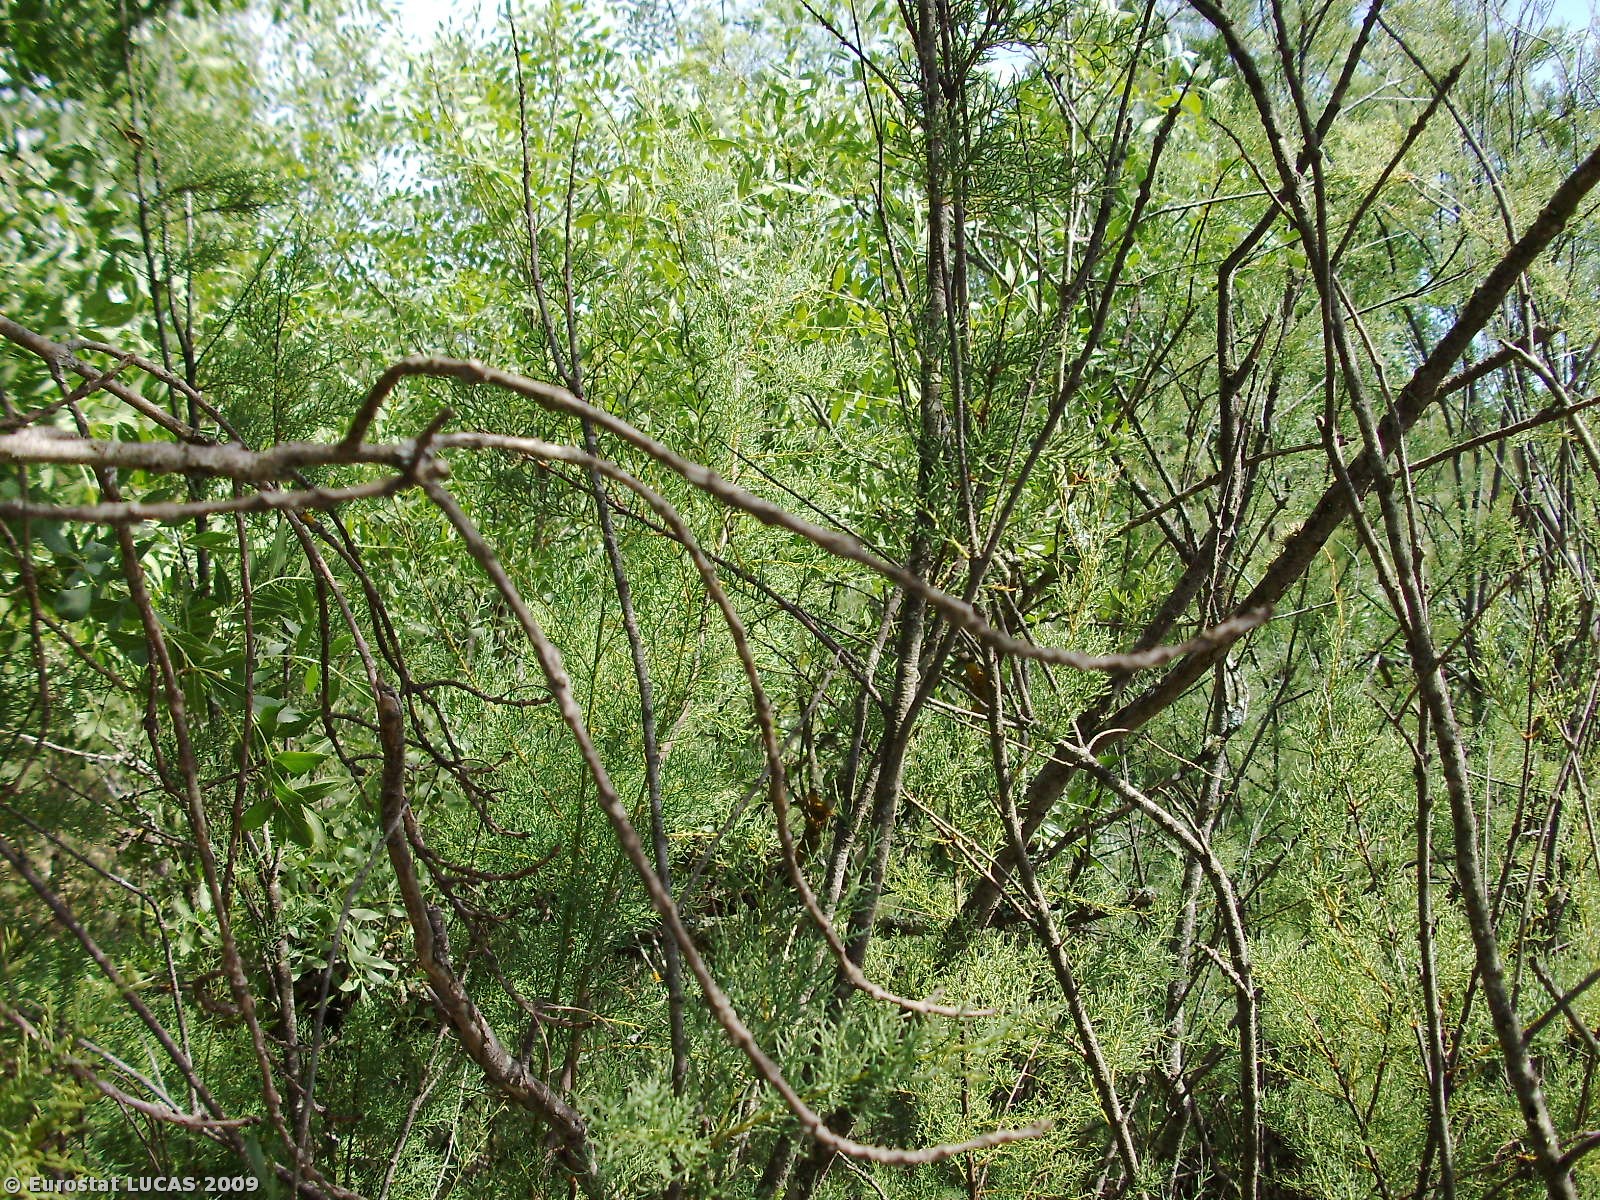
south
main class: Woodland
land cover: Mixed woodland
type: floodplain forest
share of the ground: > 75 %
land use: Unused
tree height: > 5 m
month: June
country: PT
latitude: 38.0342
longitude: -8.3722
